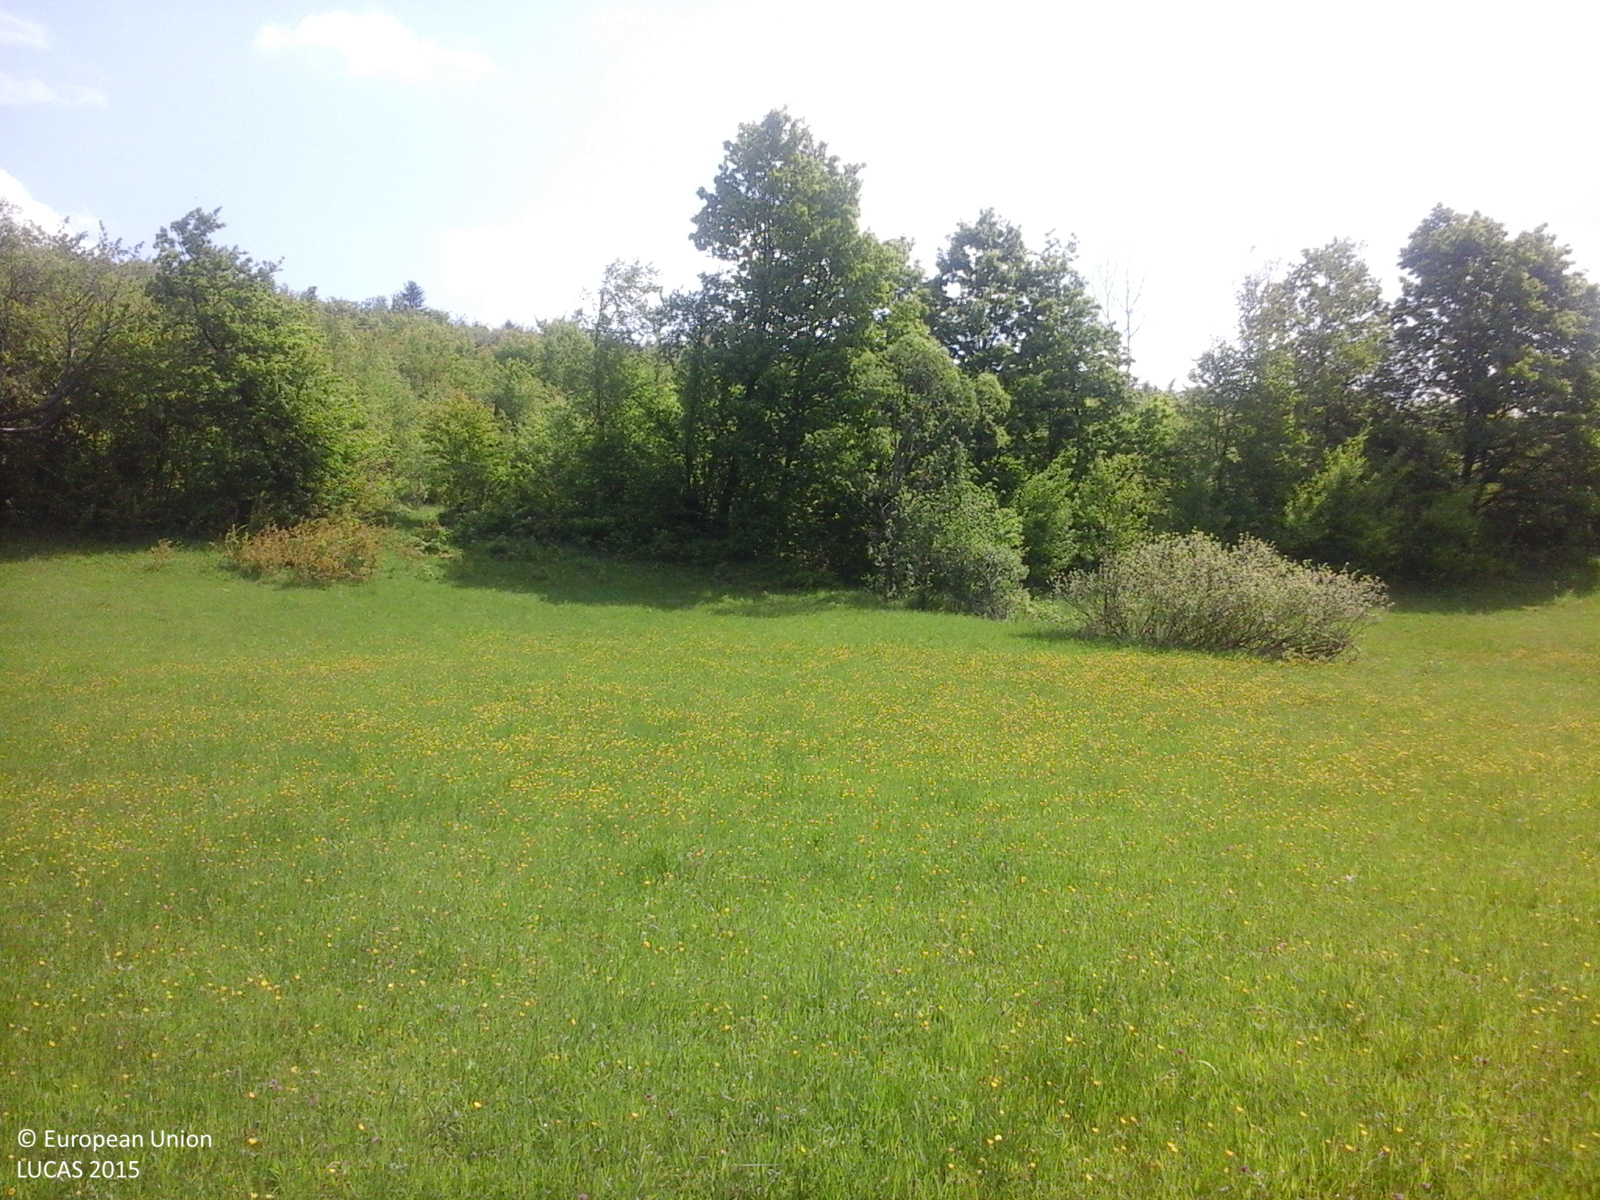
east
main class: Grassland
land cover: Grassland without tree/shrub cover
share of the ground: > 75 %
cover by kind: herbaceous plants 100 %
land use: Agriculture (excluding fallow land and kitchen gardens)
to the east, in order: Grassland without tree/shrub cover; Broadleaved woodland; Grassland without tree/shrub cover; Other fruit trees and berries
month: May
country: RO
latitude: 45.9761
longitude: 26.2702
